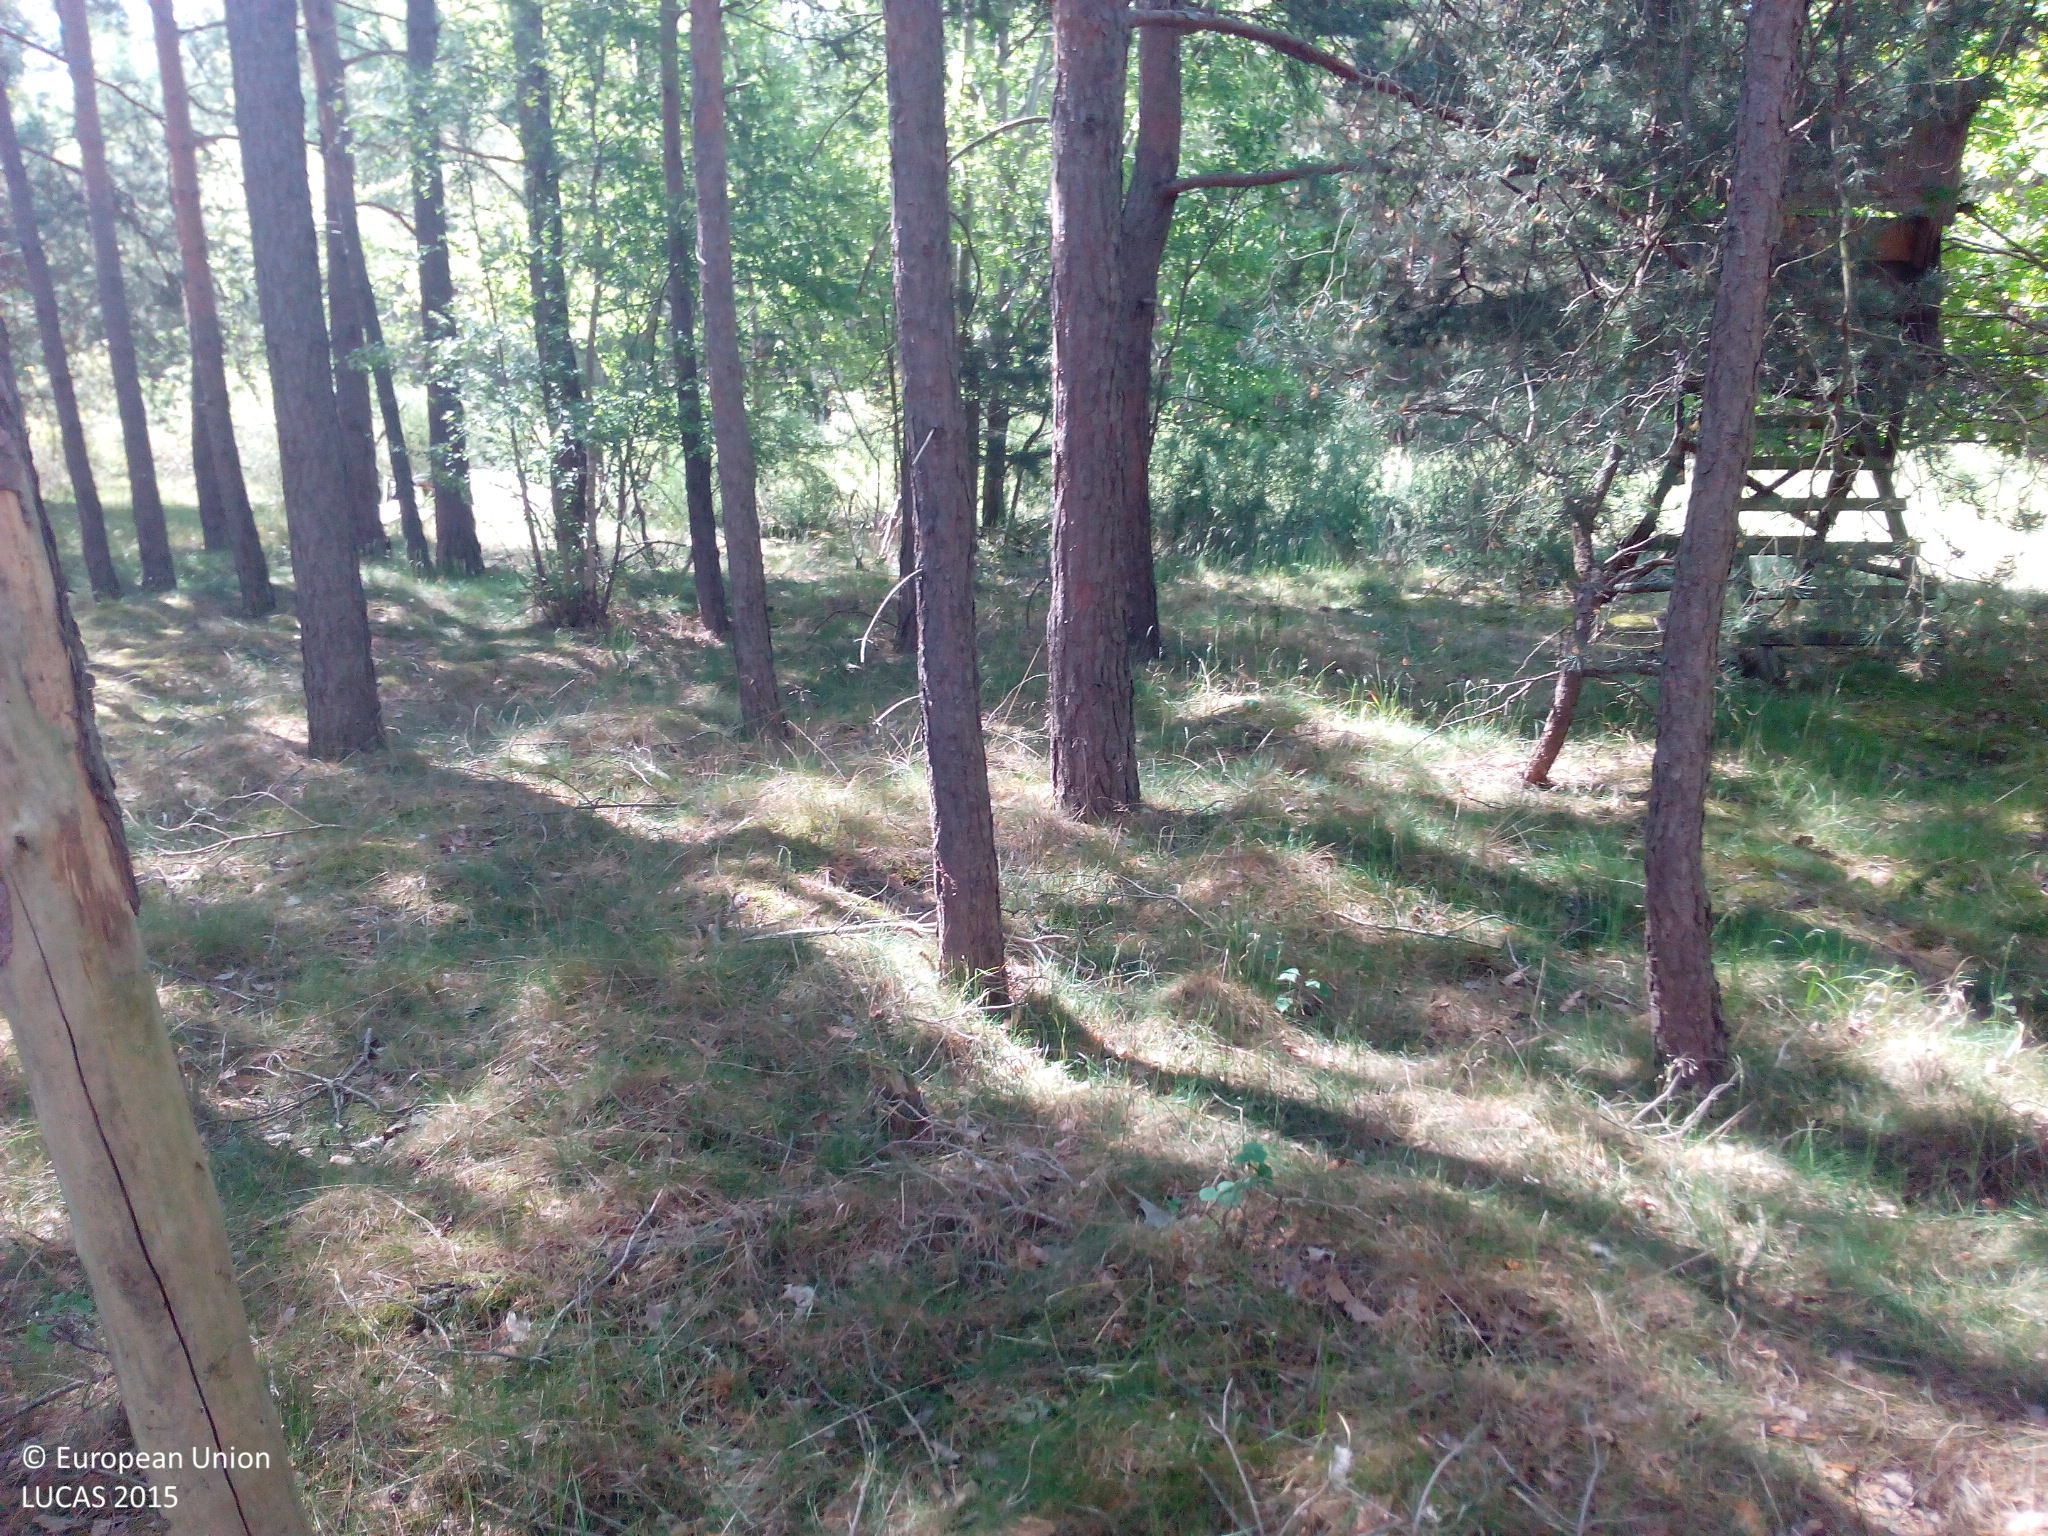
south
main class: Woodland
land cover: Pine dominated coniferous woodland
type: hemiboreal forest and nemoral coniferous forest and mixed broadleaved-coniferous forest
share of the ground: > 75 %
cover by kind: coniferous forest trees 90 %, herbaceous plants 5 %, lichens and mosses 5 %
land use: Forestry
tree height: > 5 m
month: June
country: DE
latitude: 52.3491
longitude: 12.5981
